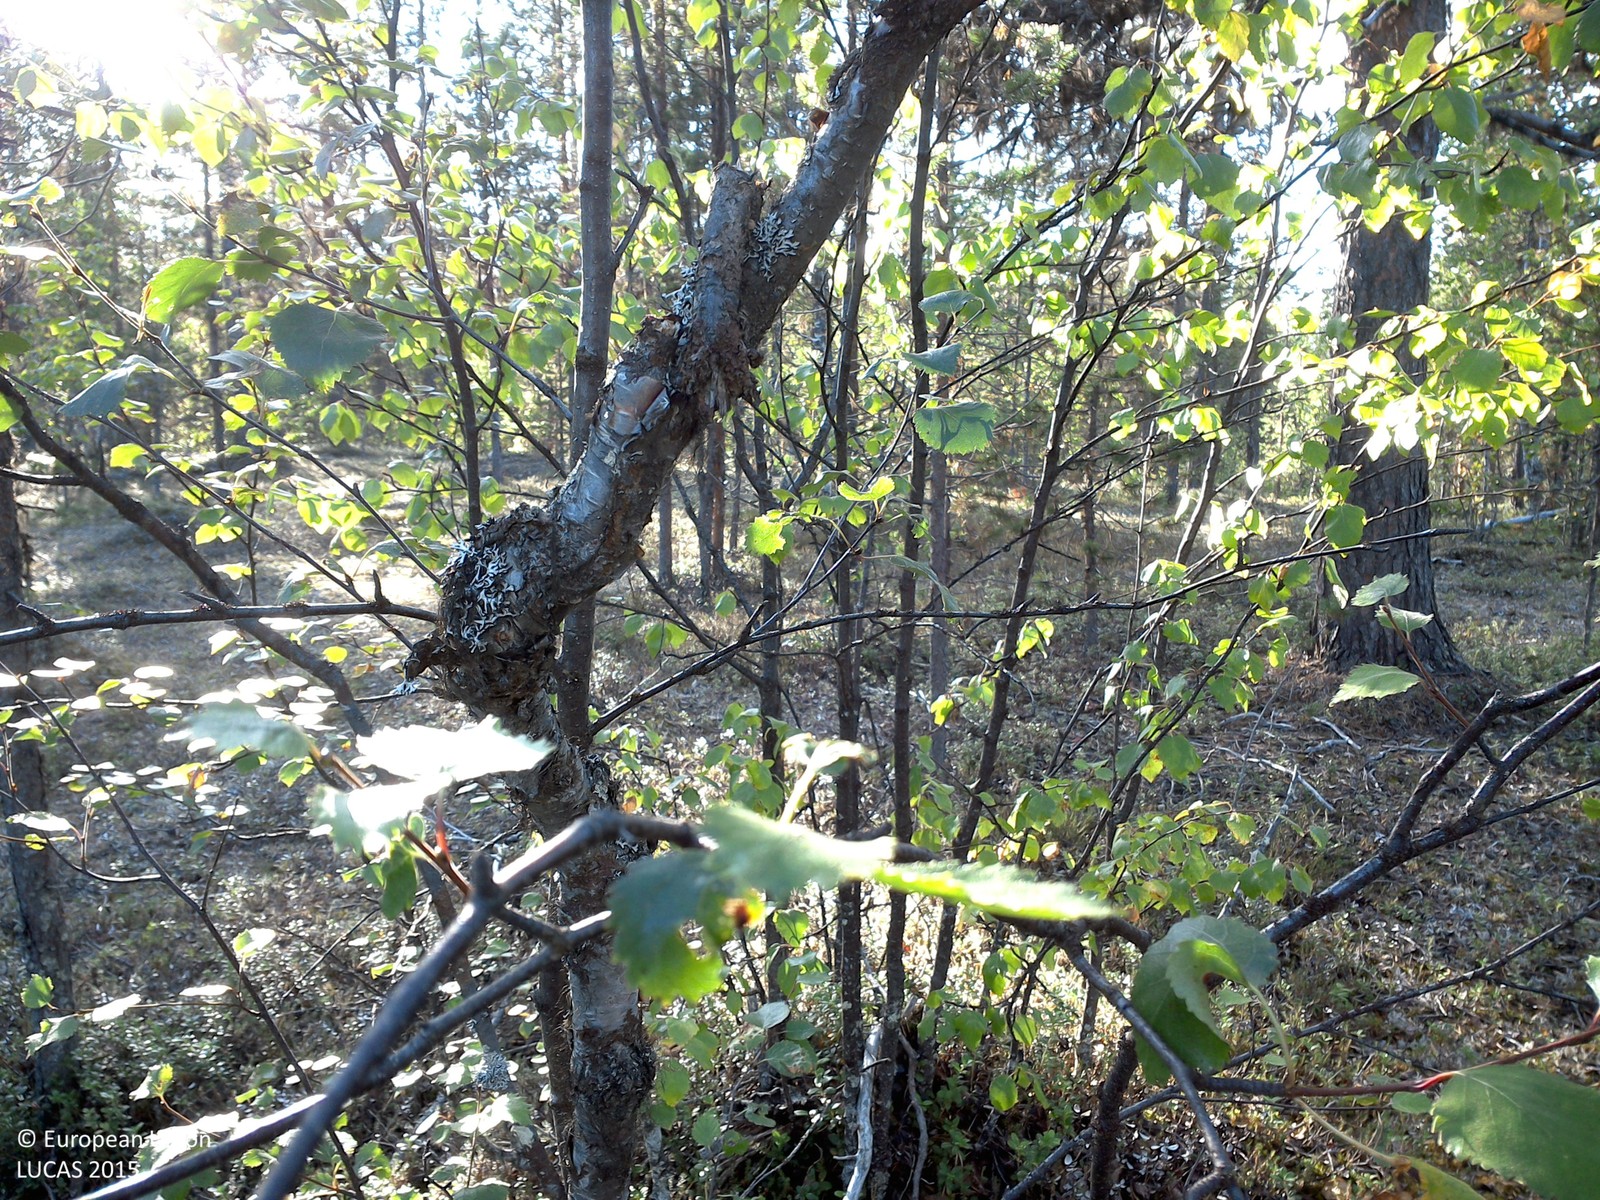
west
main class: Woodland
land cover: Pine dominated mixed woodland
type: boreal forest
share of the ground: 25 - 50 %
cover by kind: shrubs 35 %, lichens and mosses 30 %, coniferous forest trees 25 %, broadleaved forest trees 10 %
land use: Forestry
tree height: > 5 m
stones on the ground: < 10 %
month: August
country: SE
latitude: 68.1245
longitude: 23.0615
